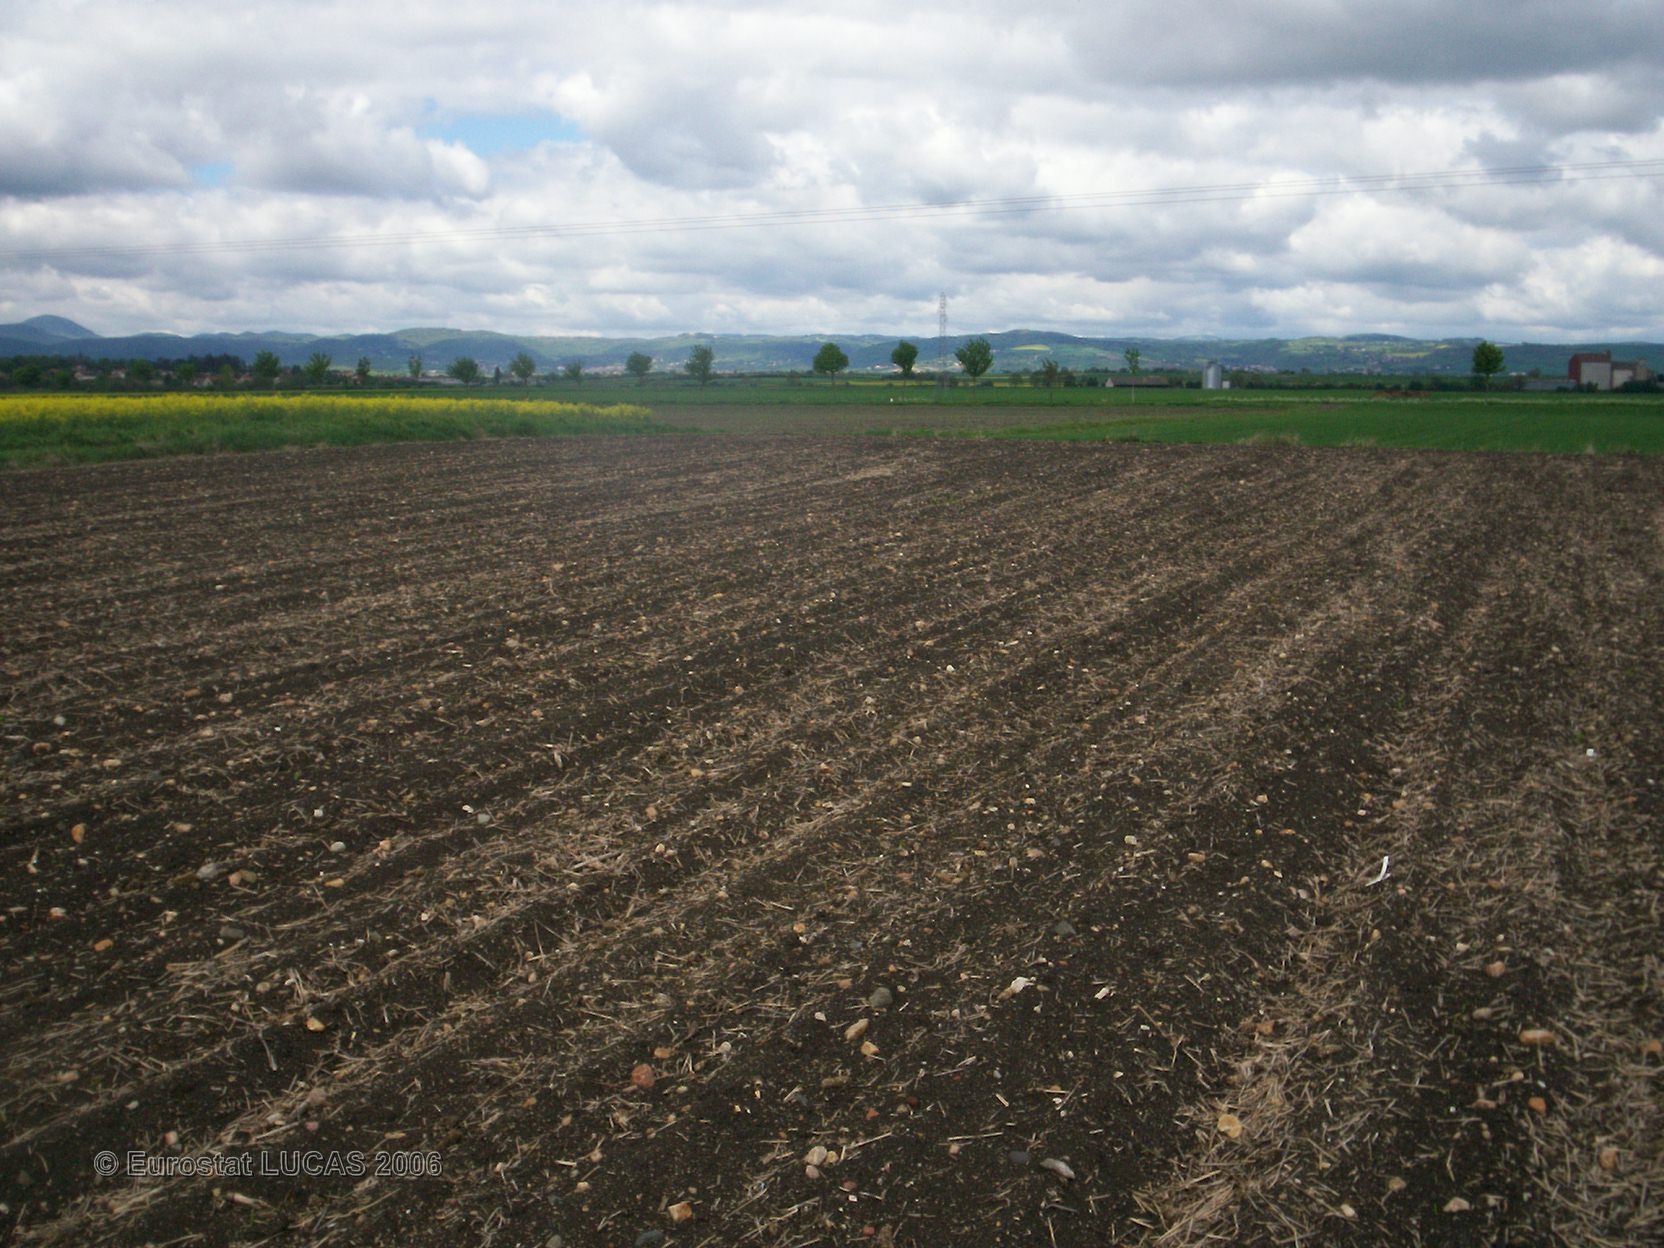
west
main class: Cropland
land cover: Maize
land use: Agriculture (excluding fallow land and kitchen gardens)
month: May
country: FR
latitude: 45.9344
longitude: 3.1769
